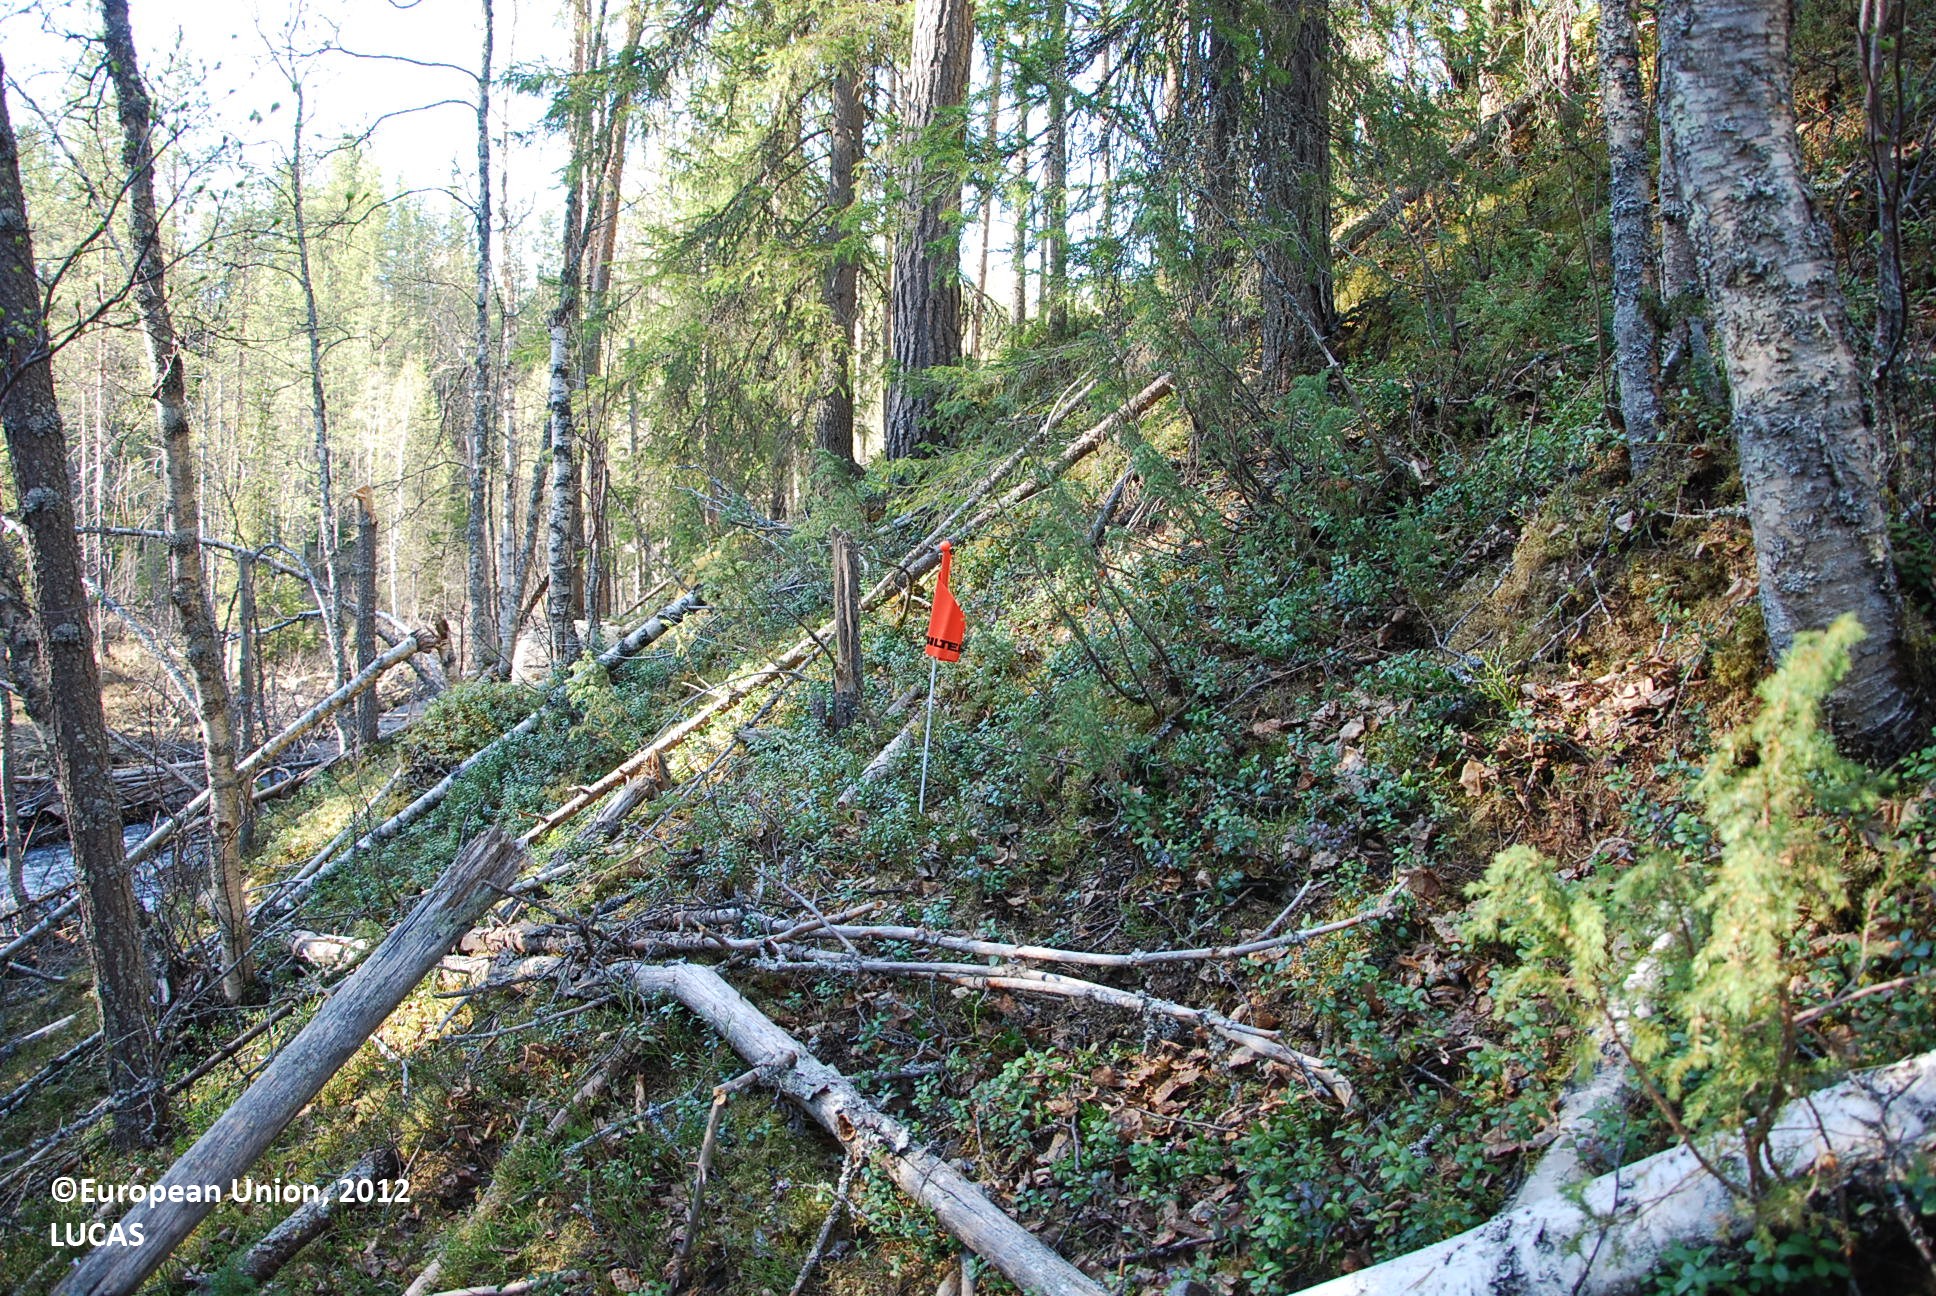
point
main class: Woodland
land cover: Pine dominated mixed woodland
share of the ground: > 75 %
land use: Forestry
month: May
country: FI
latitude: 66.7426
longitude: 28.7841
